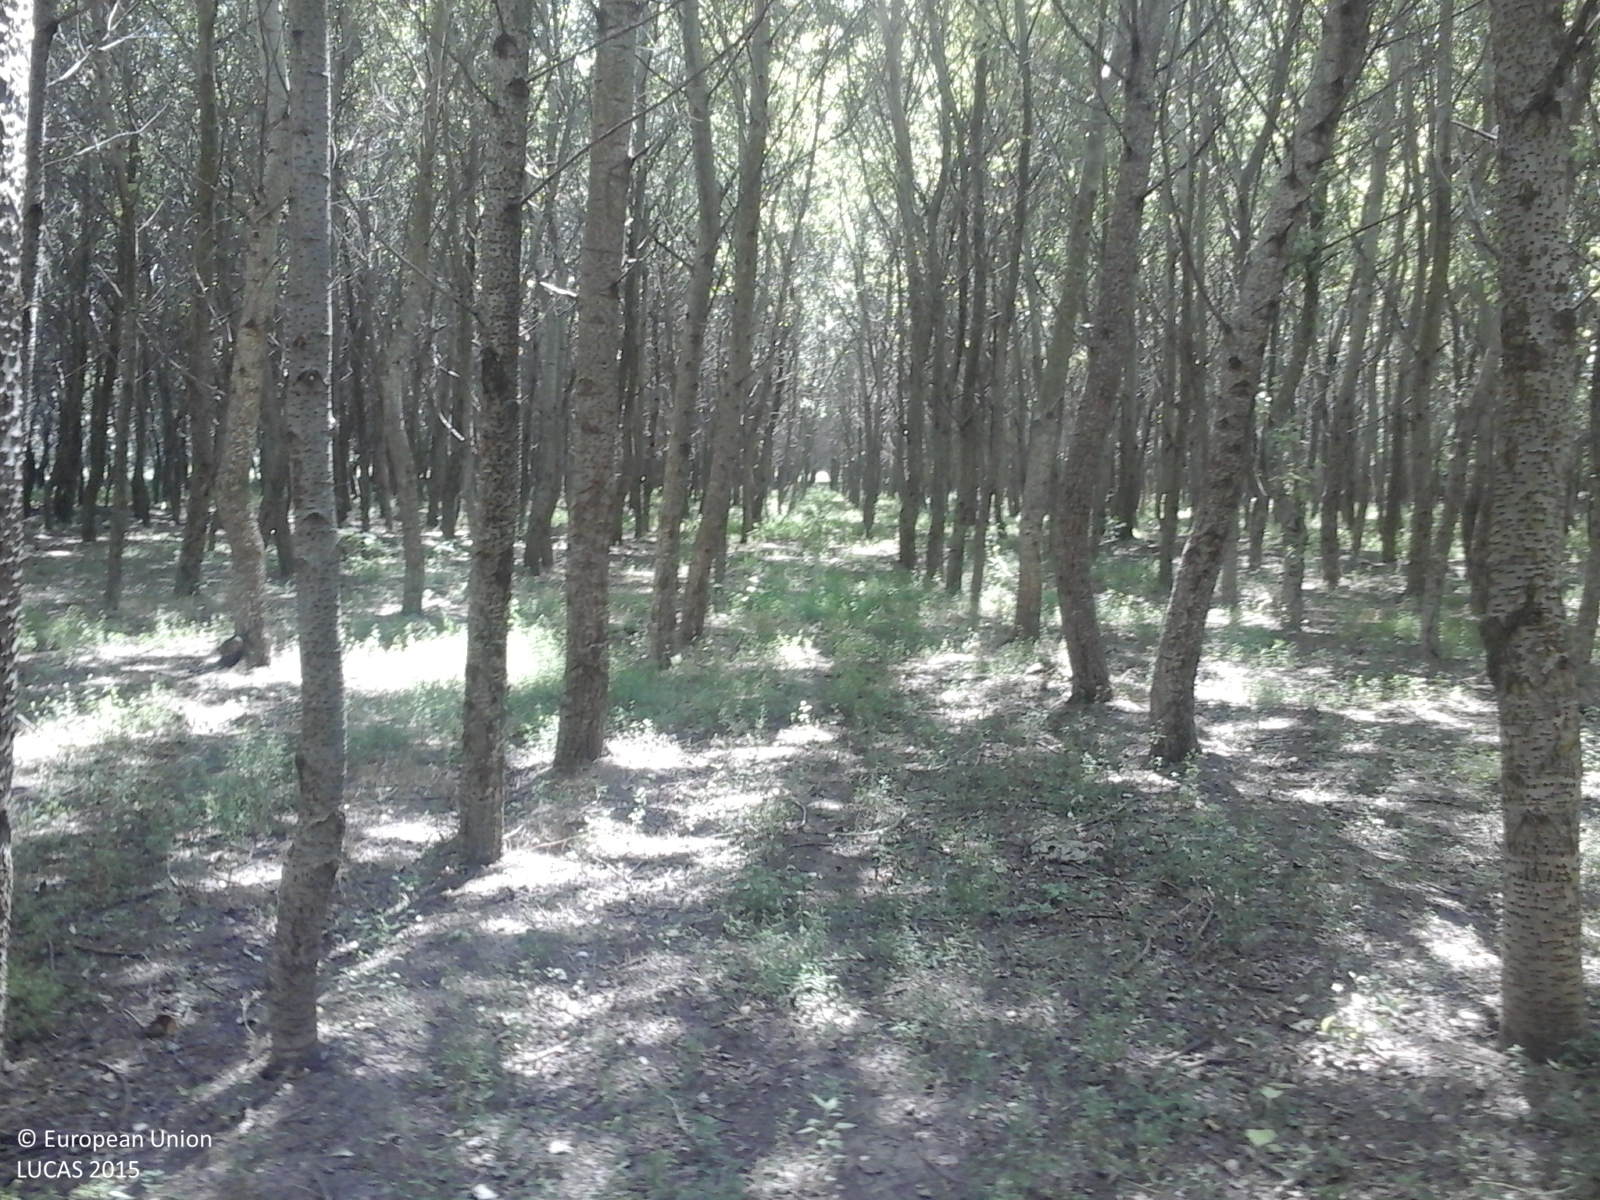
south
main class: Woodland
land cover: Broadleaved woodland
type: acidophilous oak and oak-birch forest
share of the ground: > 75 %
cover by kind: broadleaved forest trees 100 %
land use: Forestry
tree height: > 5 m
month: August
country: RO
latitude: 44.5549
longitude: 28.1787
